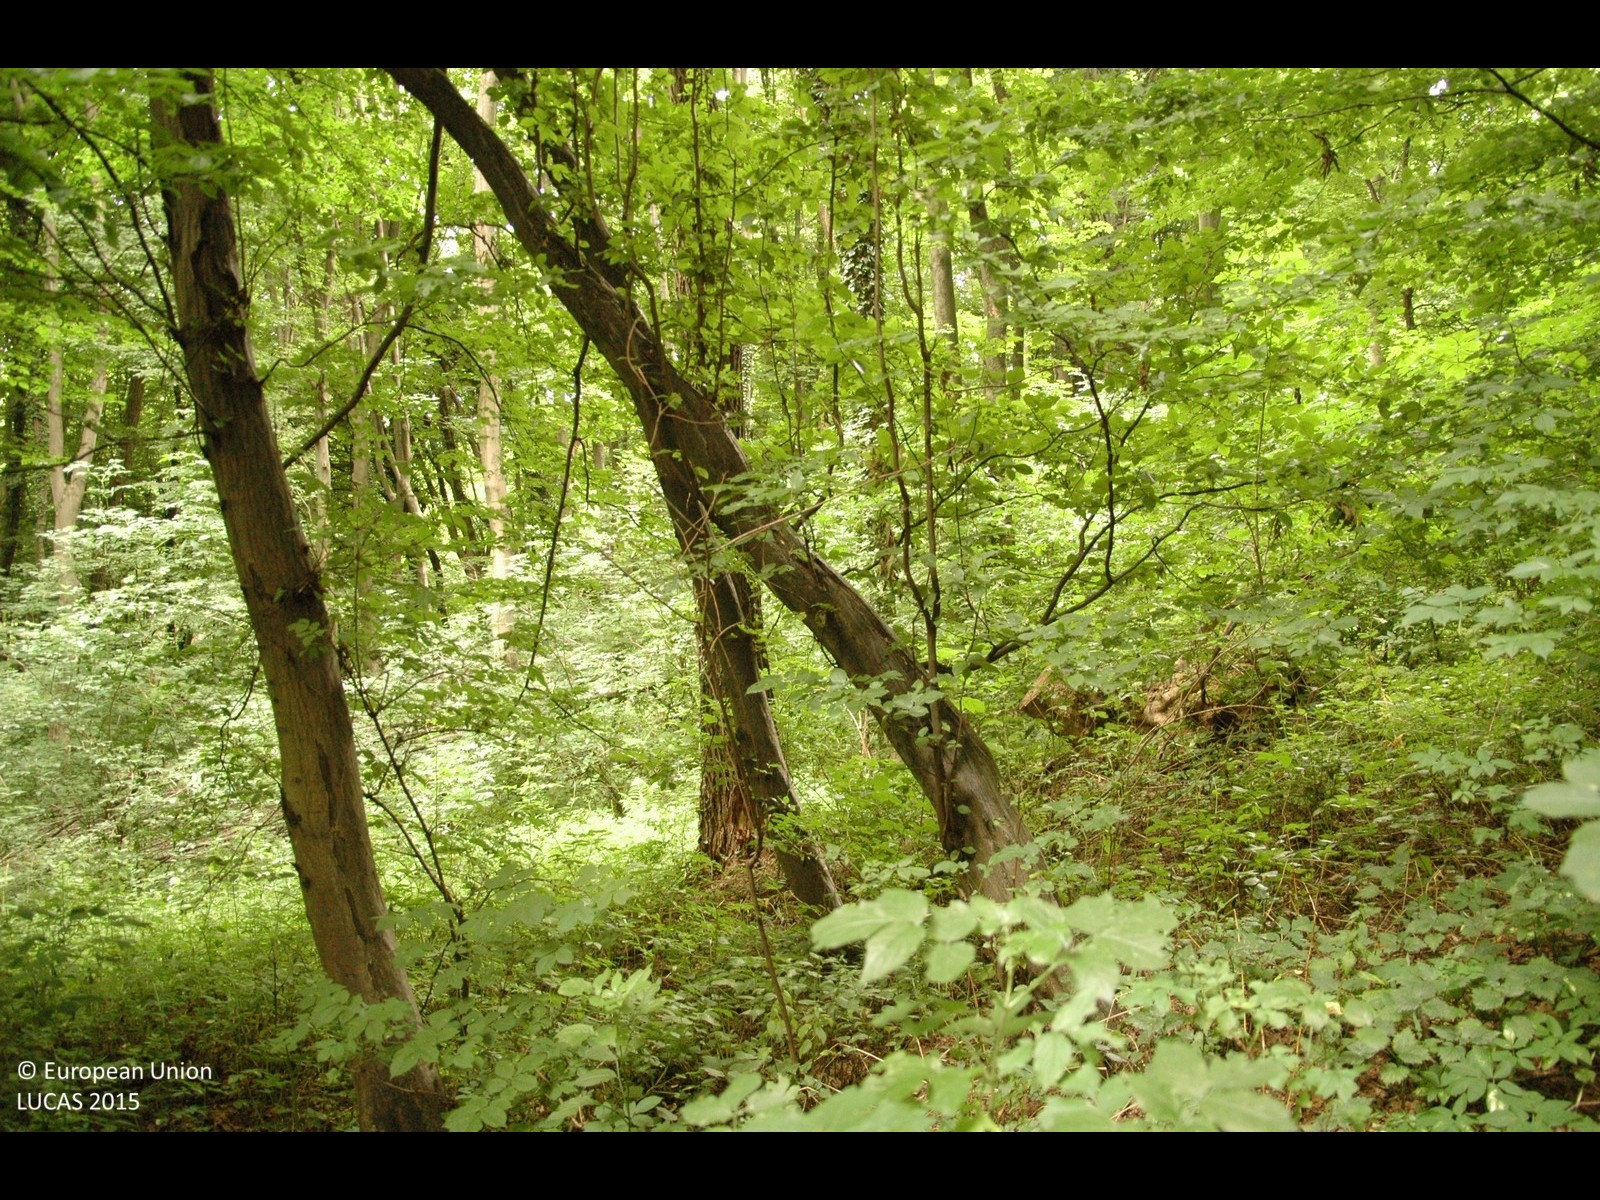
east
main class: Woodland
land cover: Broadleaved woodland
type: mesophytic deciduous forest
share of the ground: > 75 %
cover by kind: broadleaved forest trees 100 %
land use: Forestry
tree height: > 5 m
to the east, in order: Broadleaved woodland; Ditches and canals; Broadleaved woodland
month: June
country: HR
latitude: 46.4505
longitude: 16.3666
